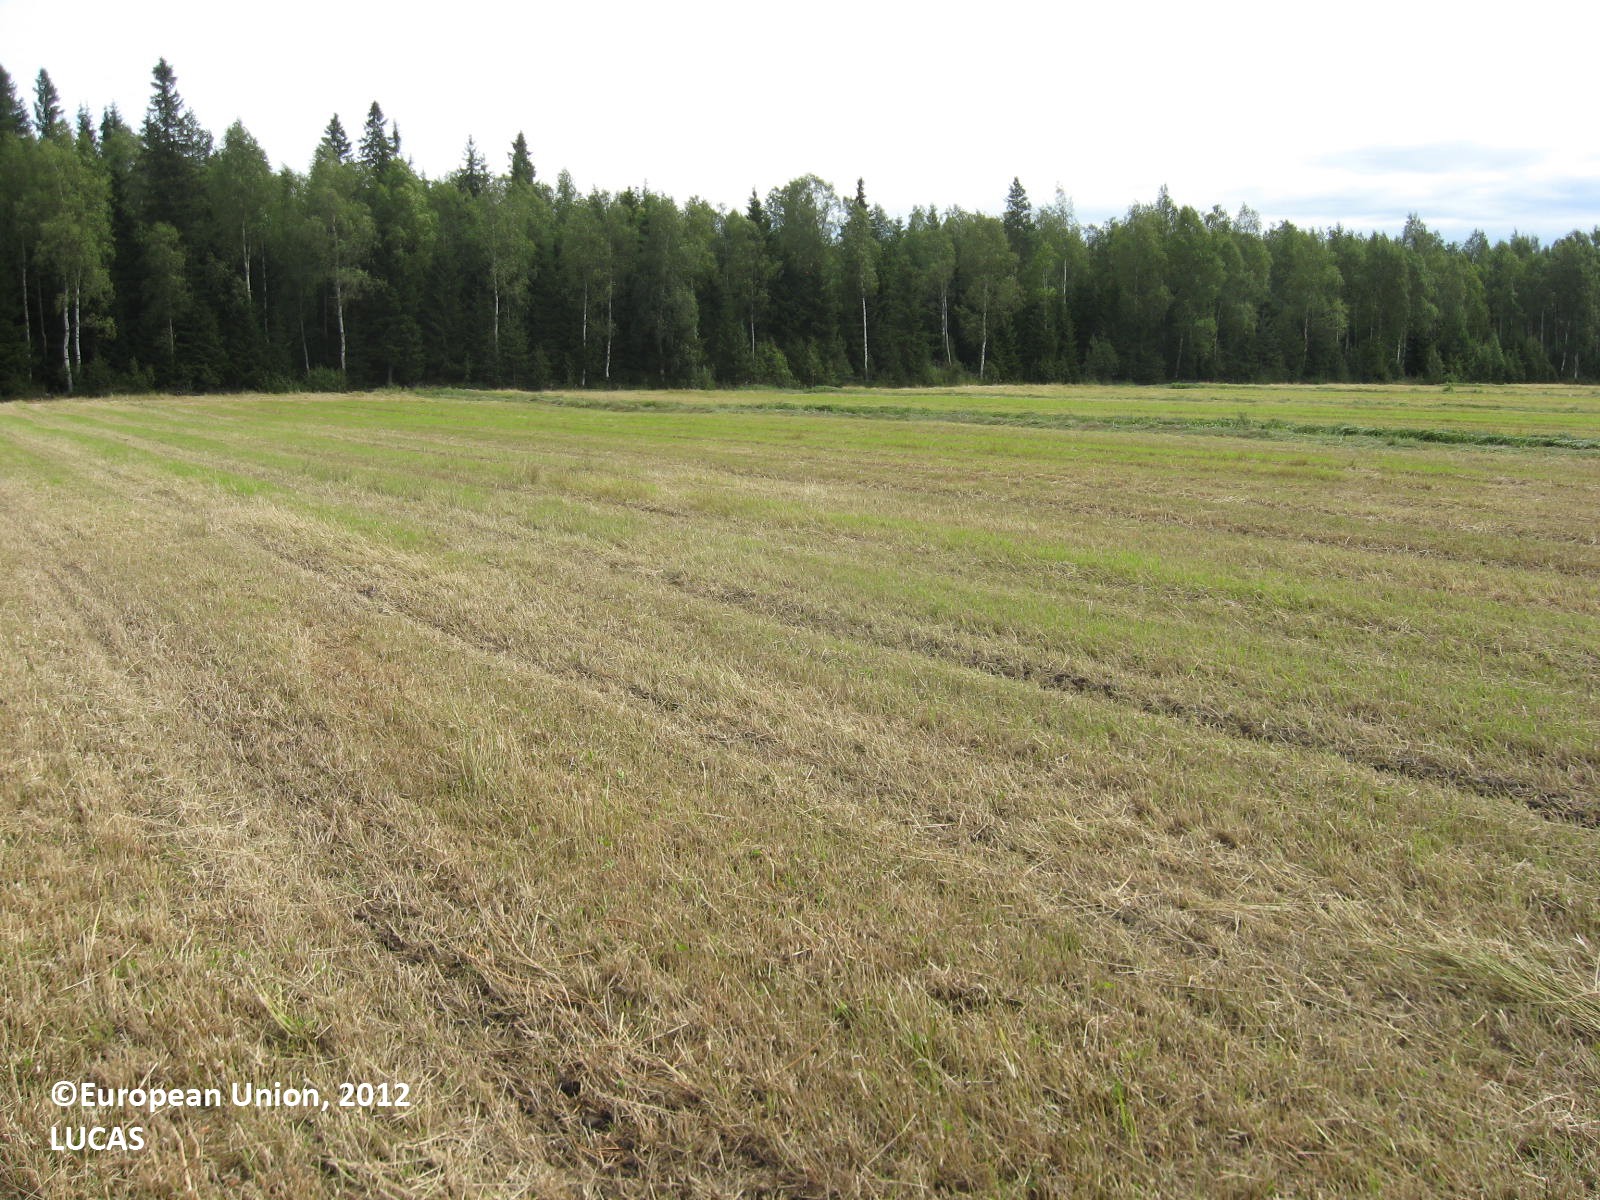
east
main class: Cropland
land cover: Temporary grasslands
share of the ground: > 75 %
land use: Agriculture (excluding fallow land and kitchen gardens)
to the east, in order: Temporary grasslands; Grass margins; Ditches and canals; Grass margins; Temporary grasslands; Grass margins; Ditches and canals; Grass margins; Temporary grasslands; Grass margins; Ditches and canals; Other mixed woodland; Ditches and canals; Spruce dominated mixed woodland
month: July
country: FI
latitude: 61.9864
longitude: 21.5175
